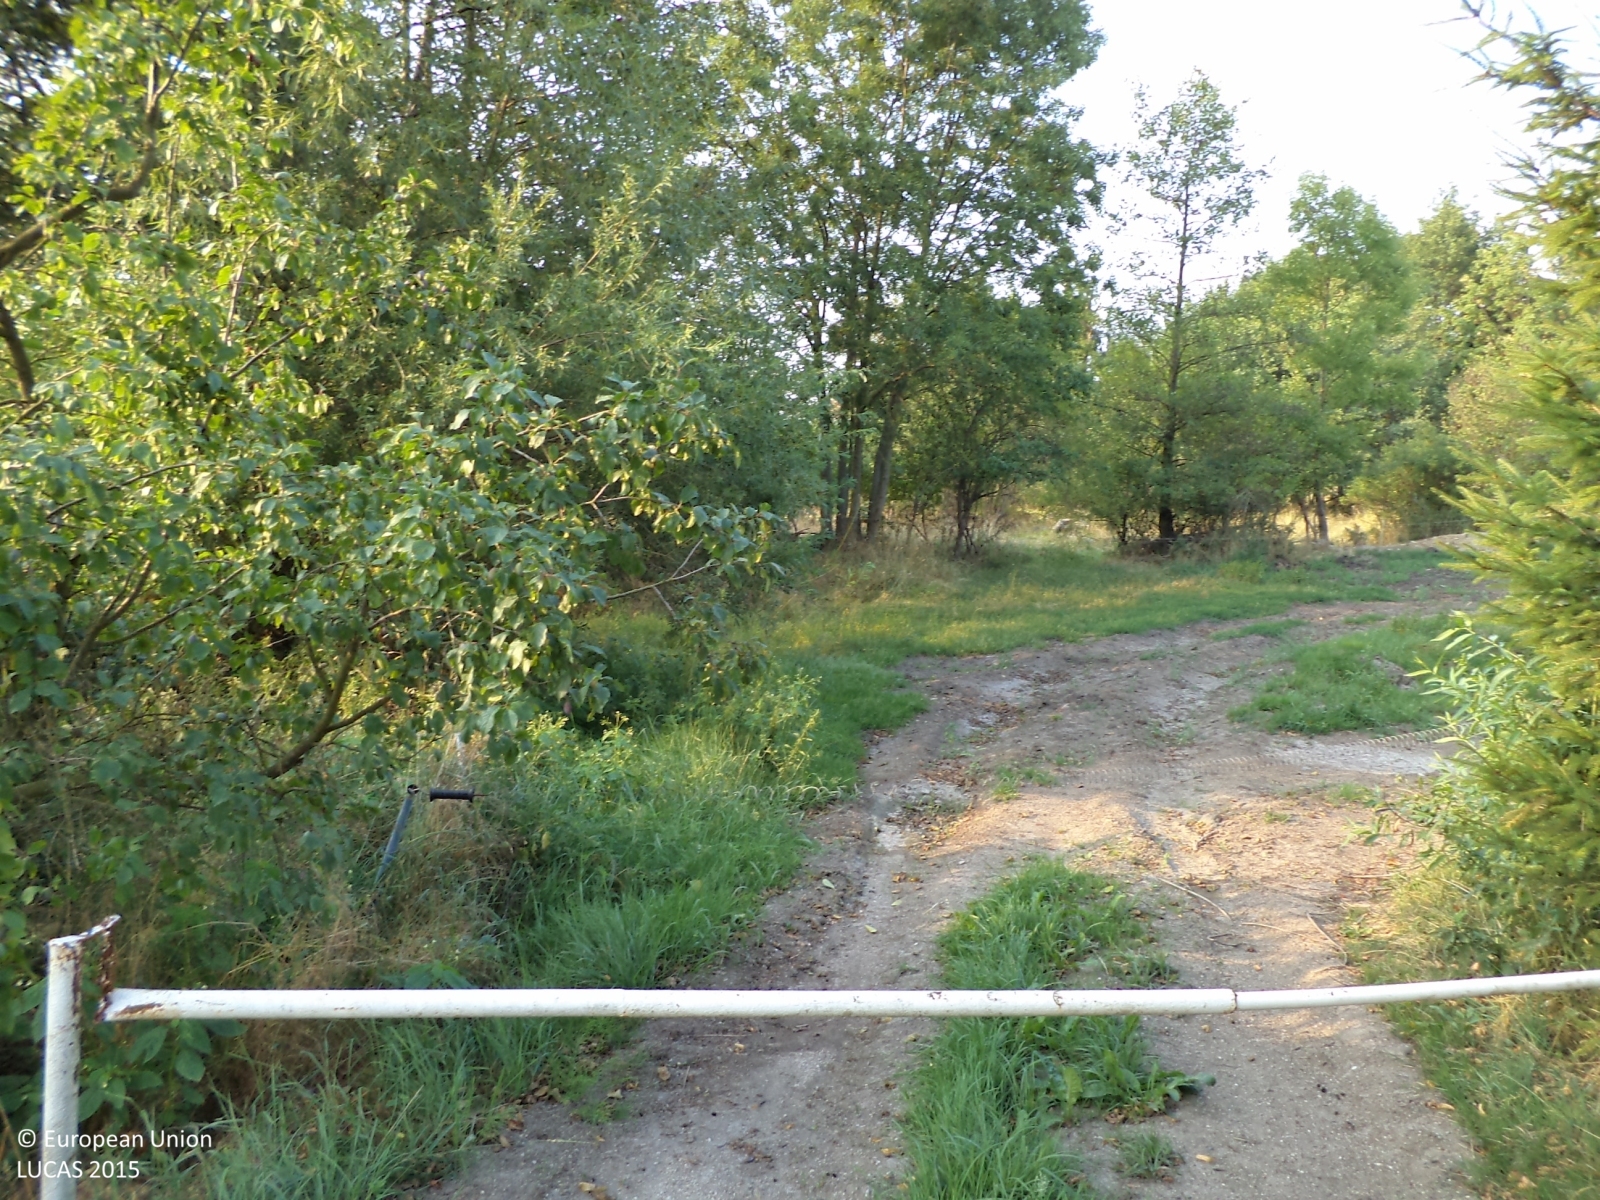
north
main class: Woodland
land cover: Spruce dominated coniferous woodland
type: hemiboreal forest and nemoral coniferous forest and mixed broadleaved-coniferous forest
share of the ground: > 75 %
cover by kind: coniferous forest trees 100 %
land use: Forestry
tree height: > 5 m
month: August
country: CZ
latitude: 49.5564
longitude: 14.4666
